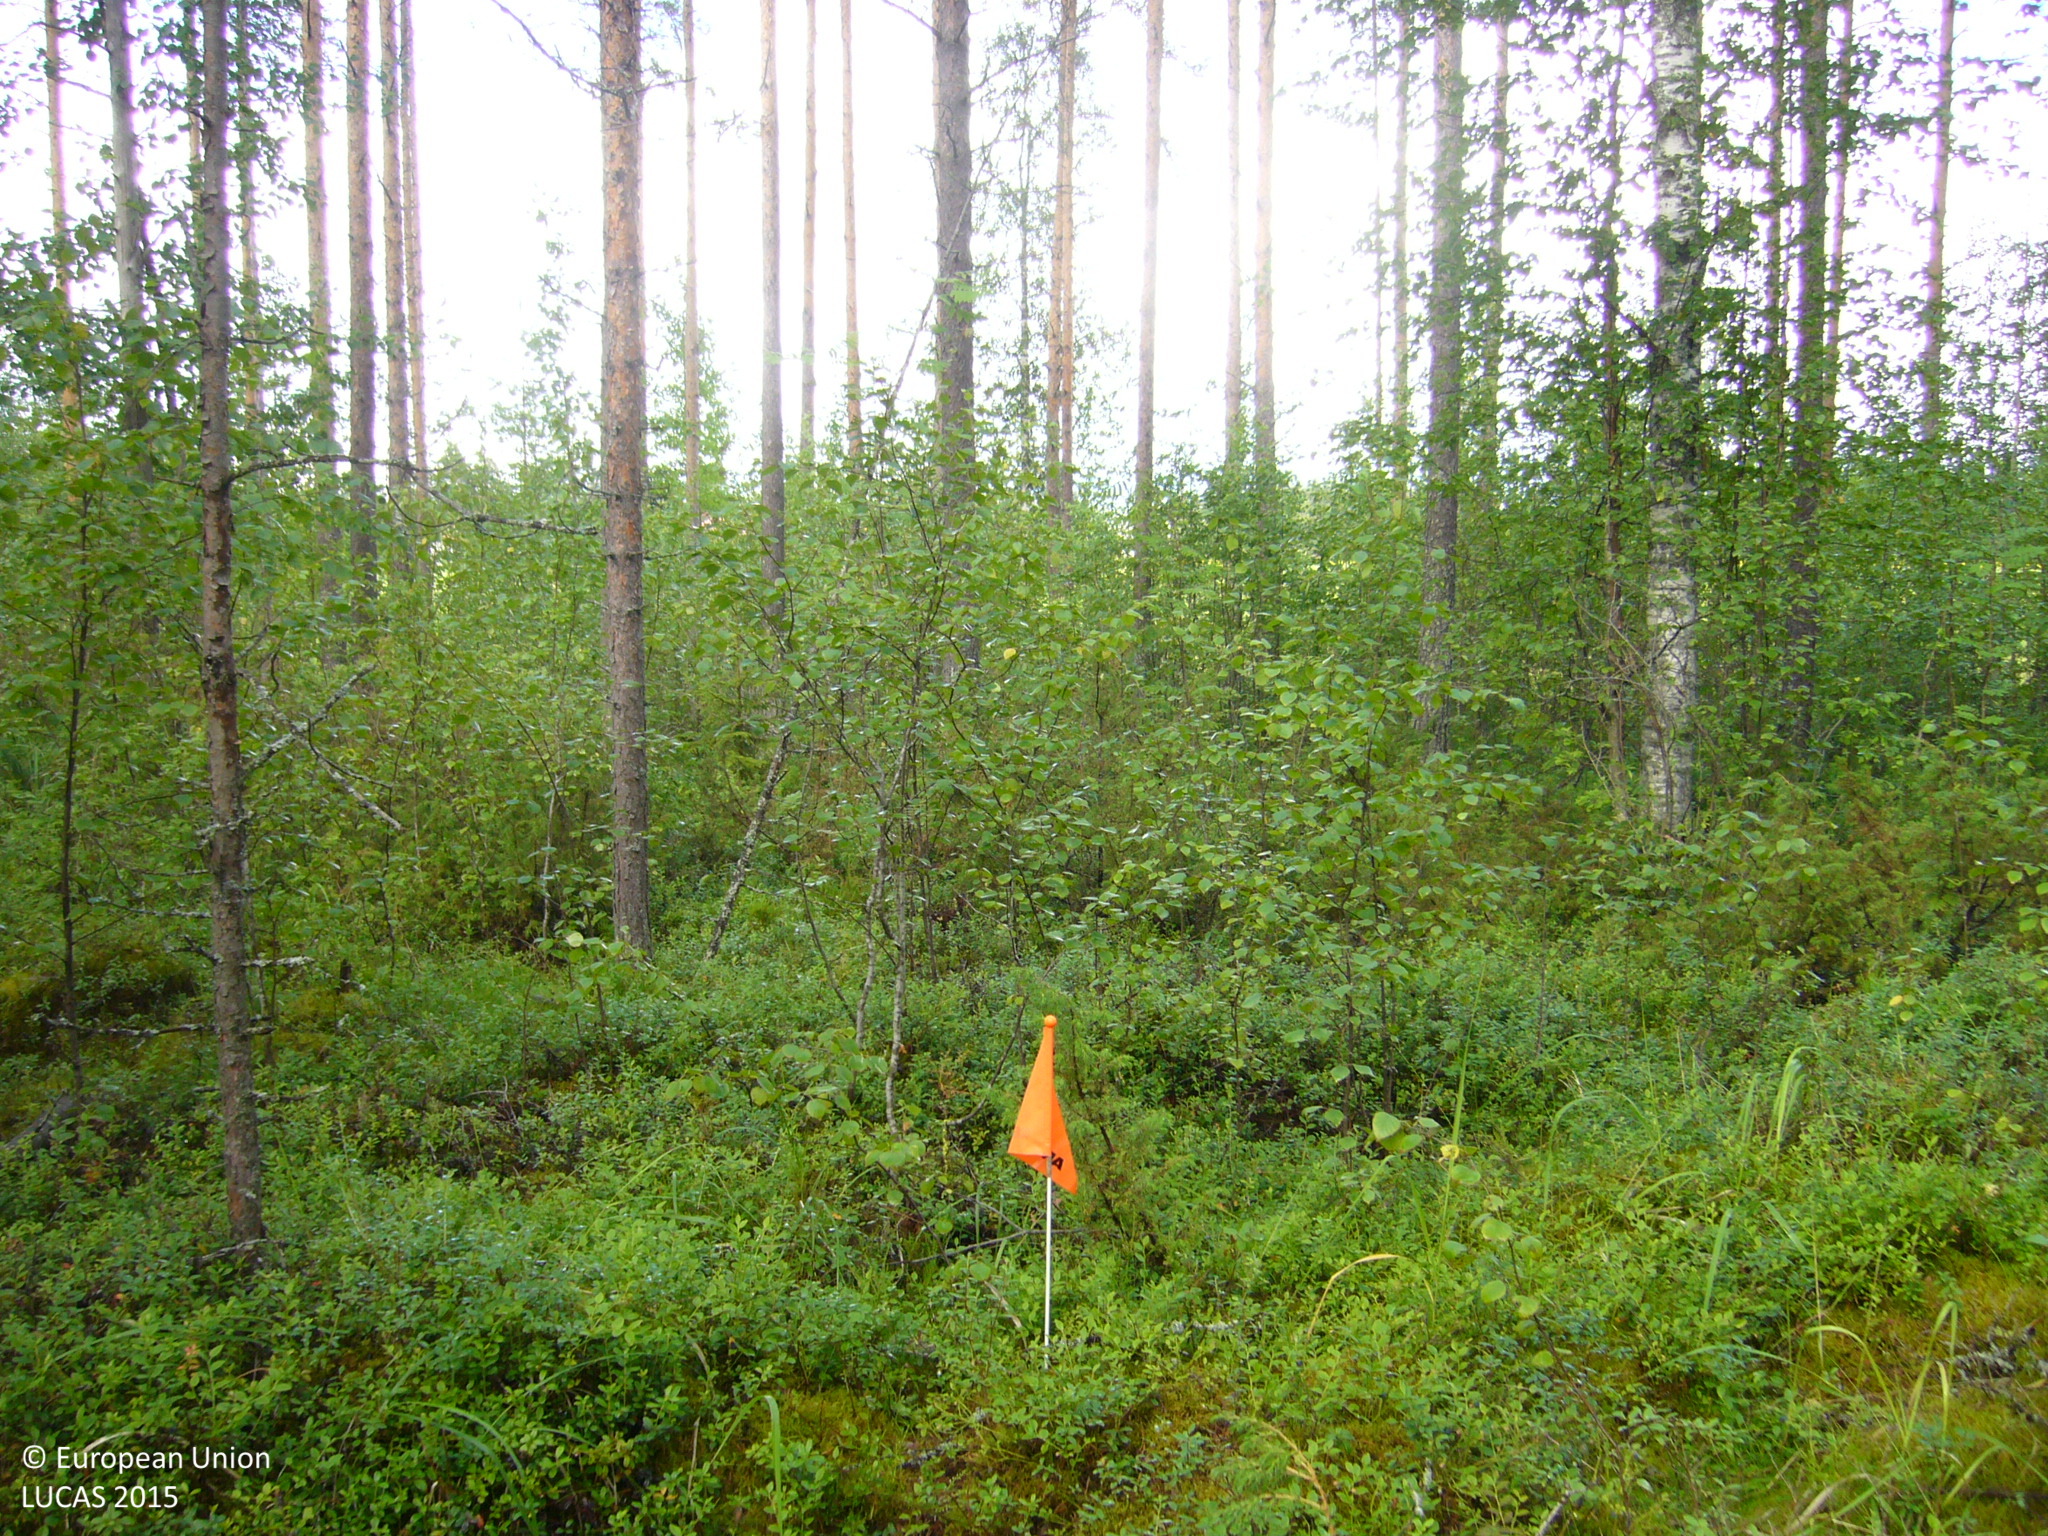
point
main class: Woodland
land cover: Pine dominated mixed woodland
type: boreal forest
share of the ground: > 75 %
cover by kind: coniferous forest trees 50 %, broadleaved forest trees 30 %, shrubs 20 %
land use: Forestry
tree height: > 5 m
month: July
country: FI
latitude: 63.9723
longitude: 25.7689
